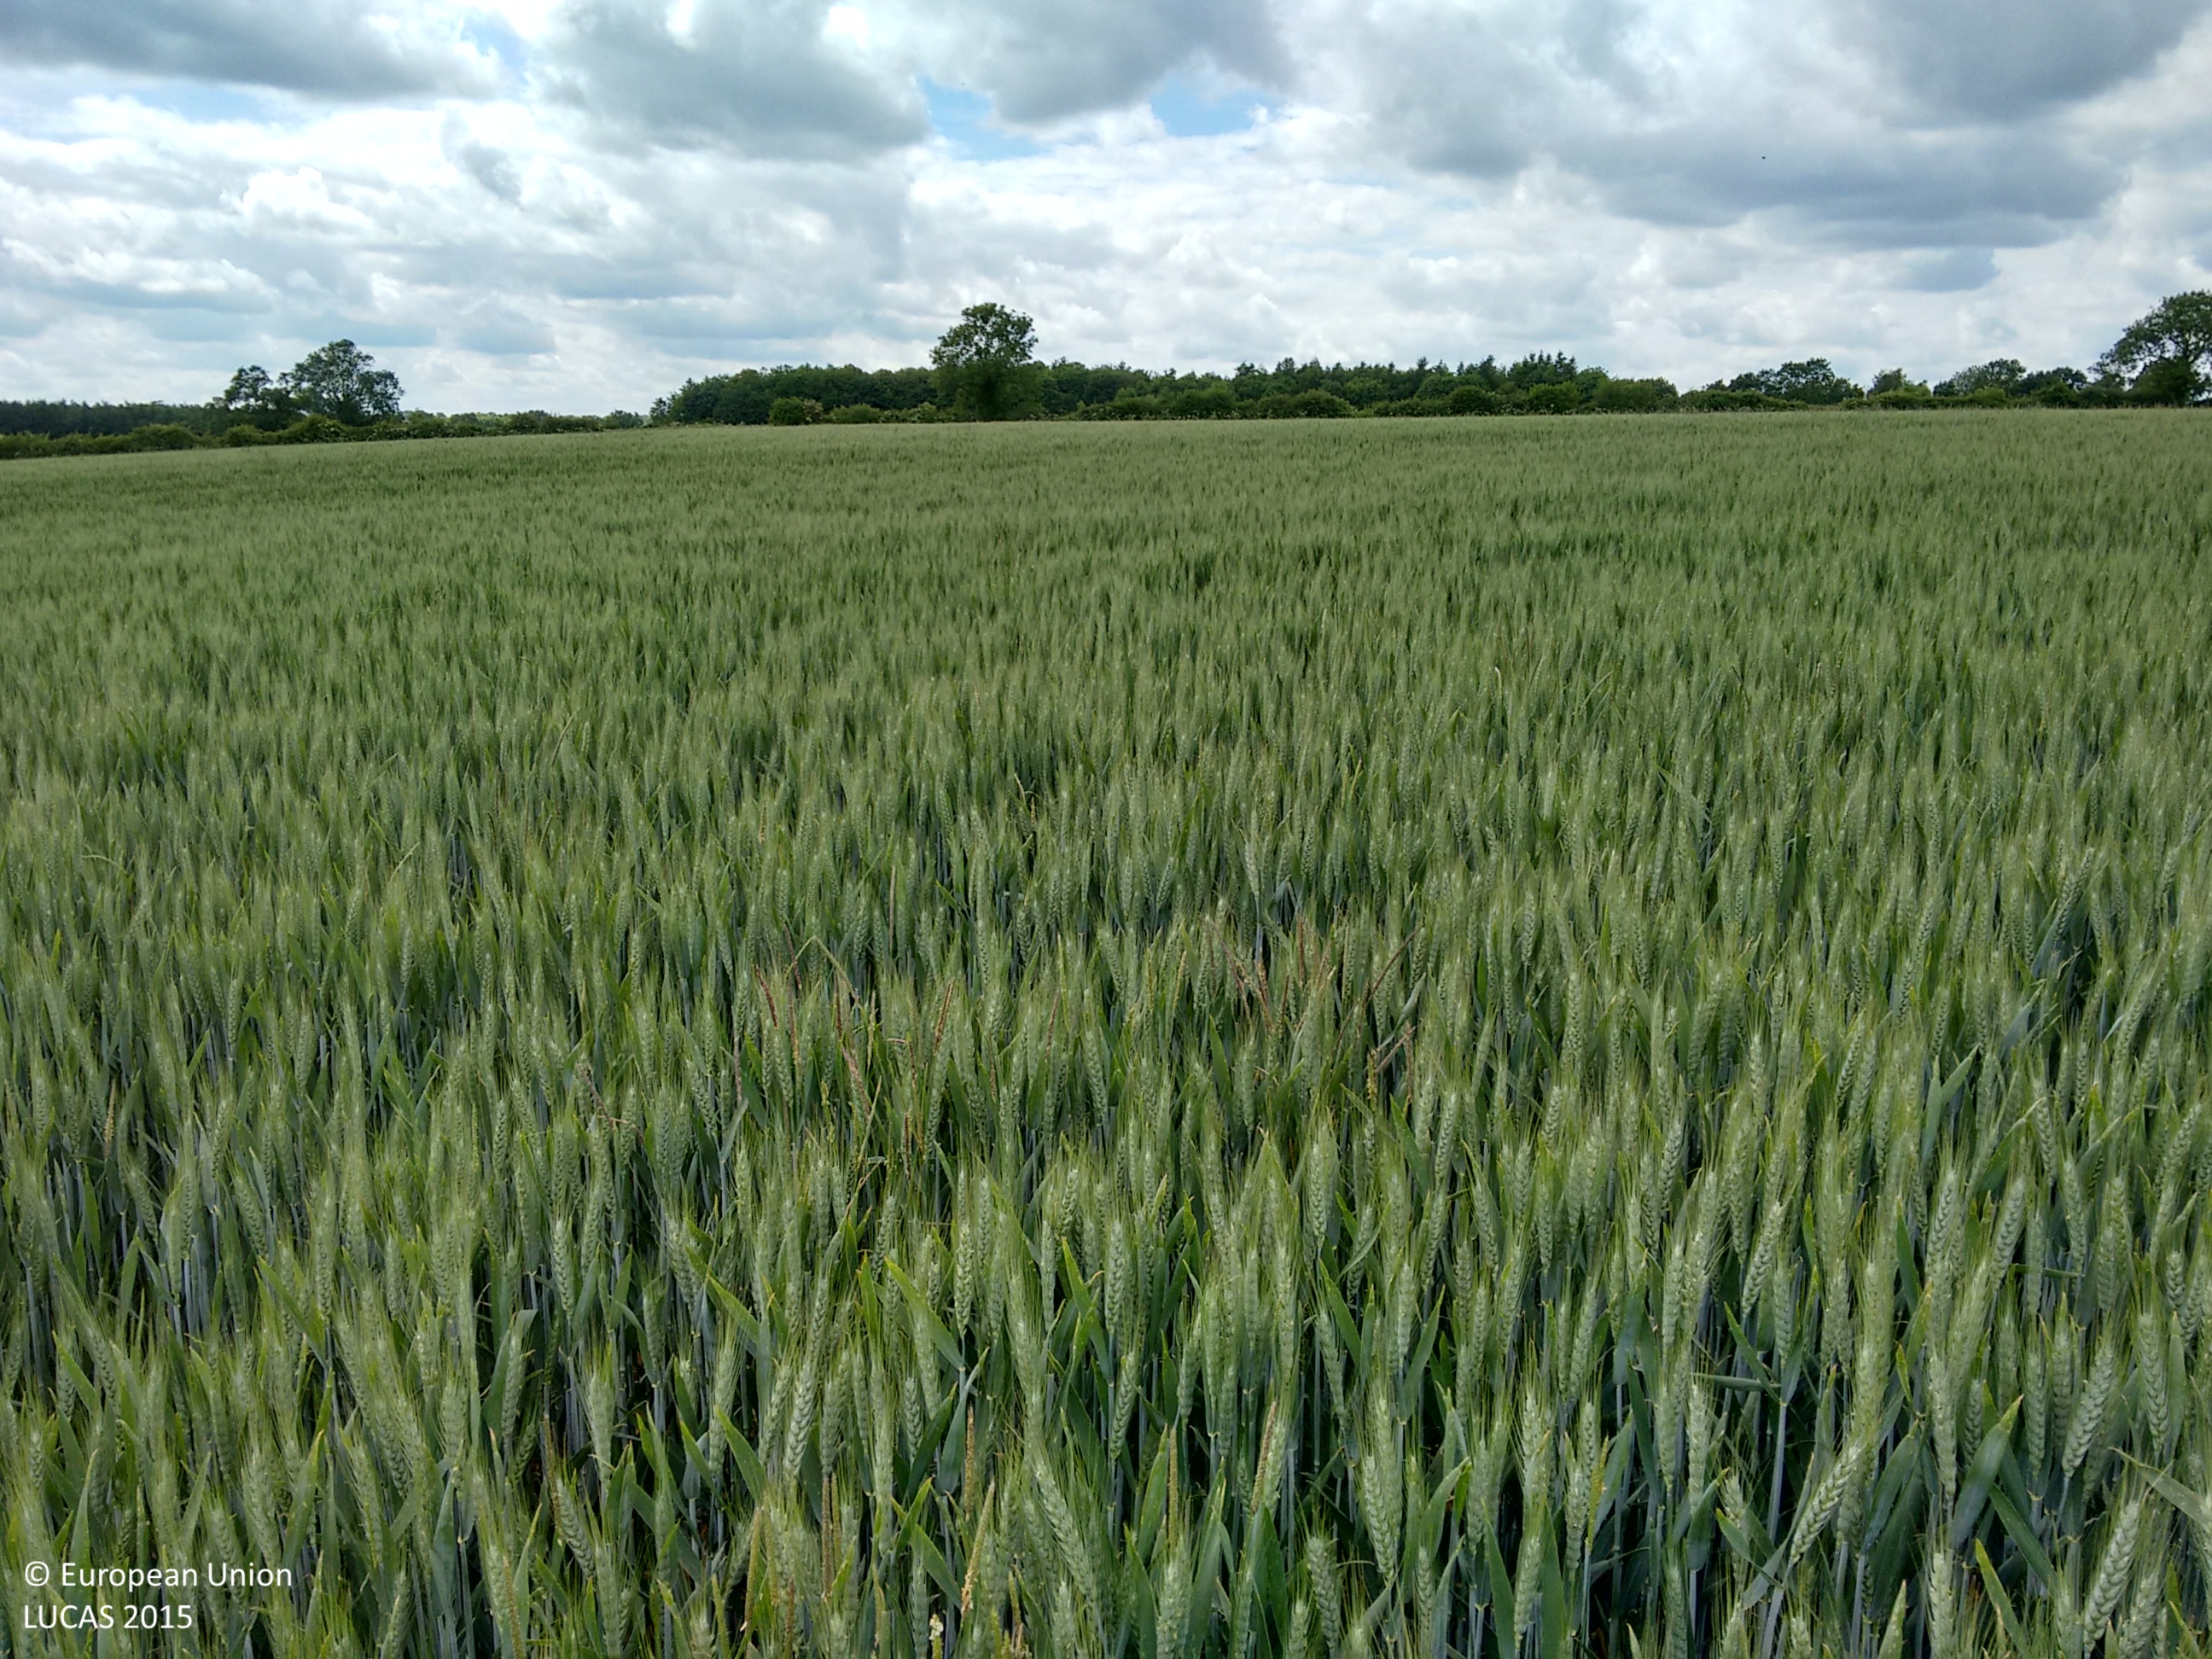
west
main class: Cropland
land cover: Common wheat
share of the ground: > 75 %
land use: Agriculture (excluding fallow land and kitchen gardens)
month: June
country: GB
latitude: 53.2031
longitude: -0.4417
